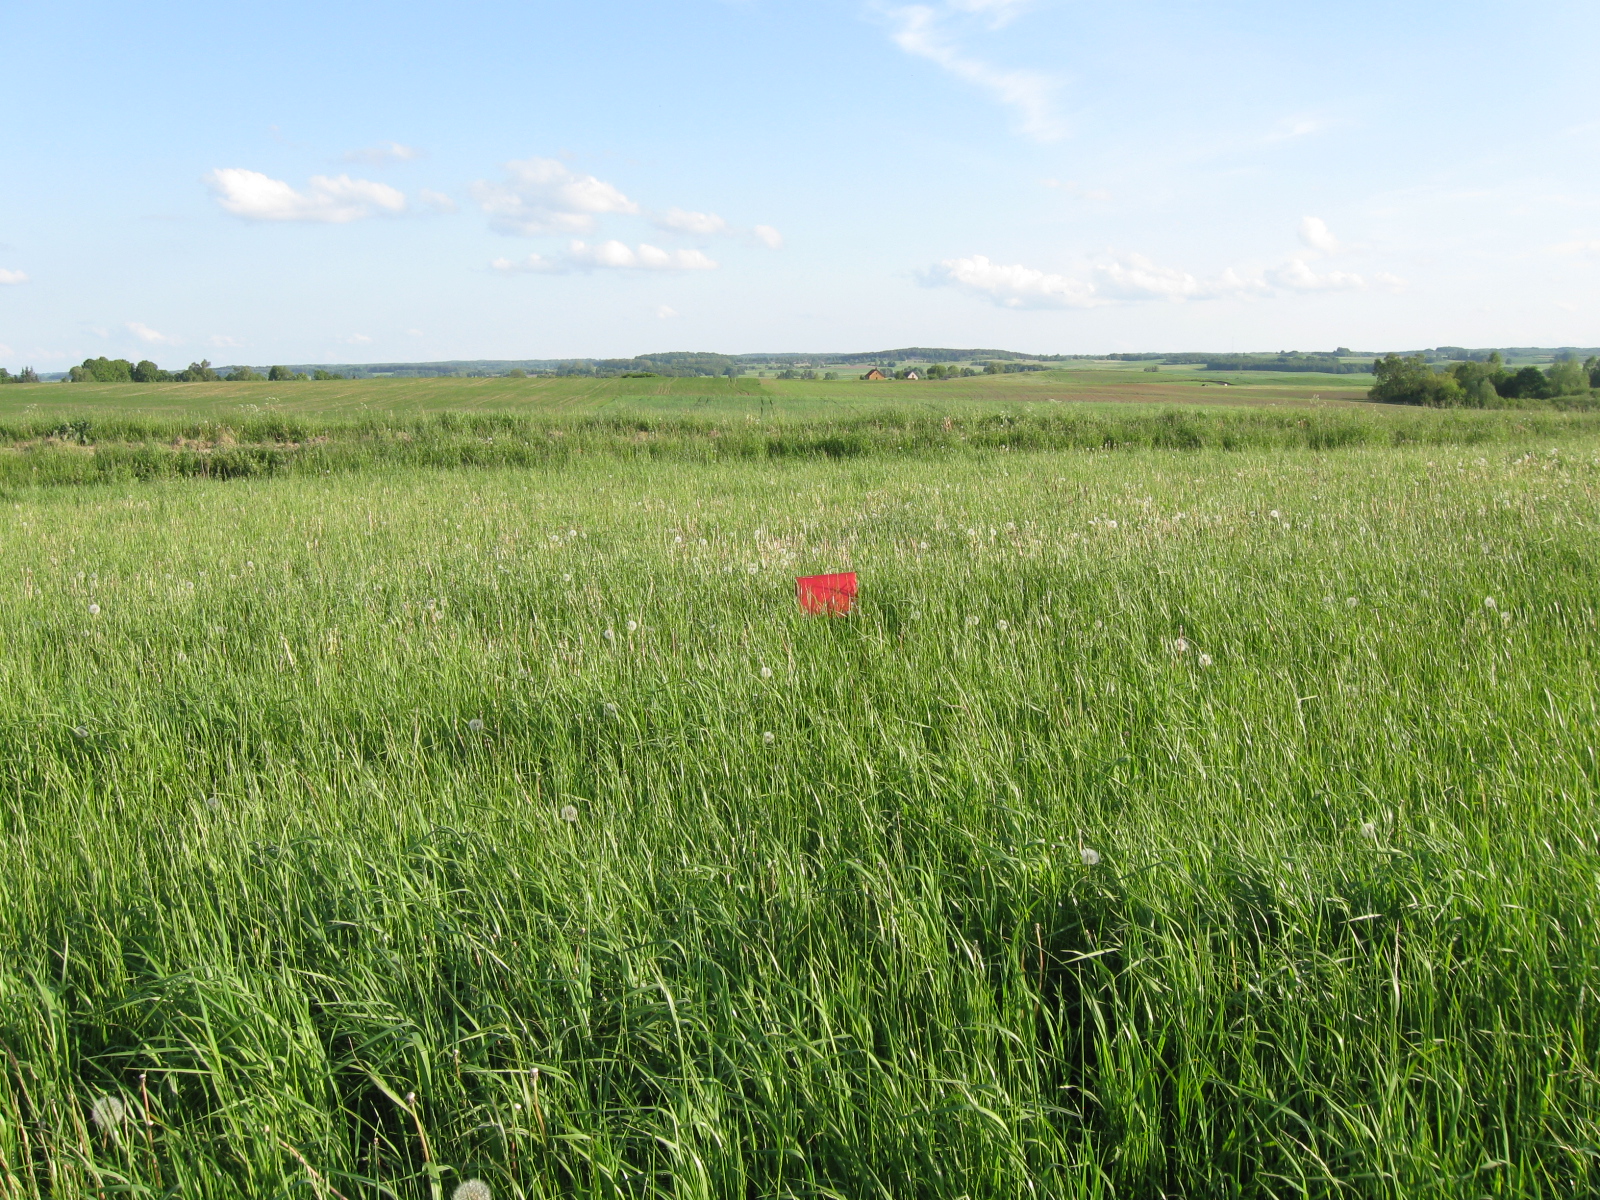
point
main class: Grassland
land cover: Grassland without tree/shrub cover
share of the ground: > 75 %
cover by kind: herbaceous plants 100 %
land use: Agriculture (excluding fallow land and kitchen gardens)
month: May
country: LT
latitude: 54.5740
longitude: 22.8316
